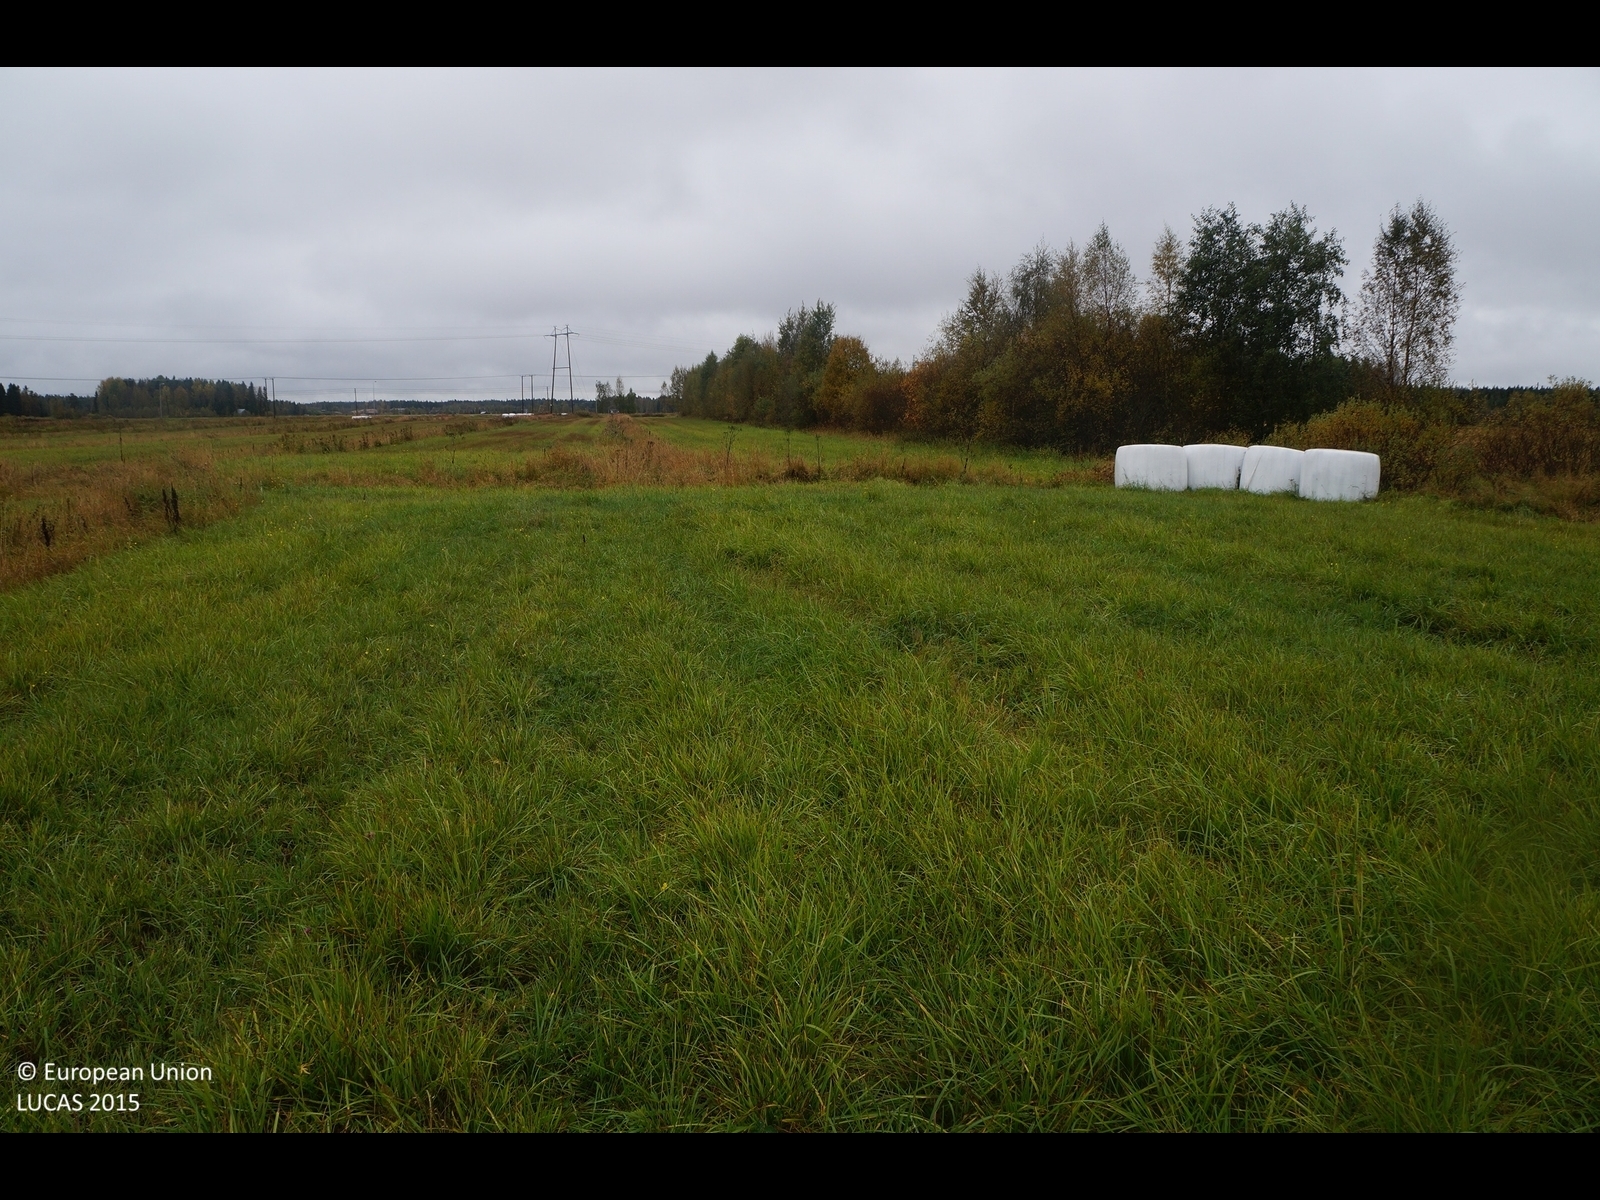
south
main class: Cropland
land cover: Temporary grasslands
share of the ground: > 75 %
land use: Agriculture (excluding fallow land and kitchen gardens)
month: September
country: FI
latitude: 64.0787
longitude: 24.4875
